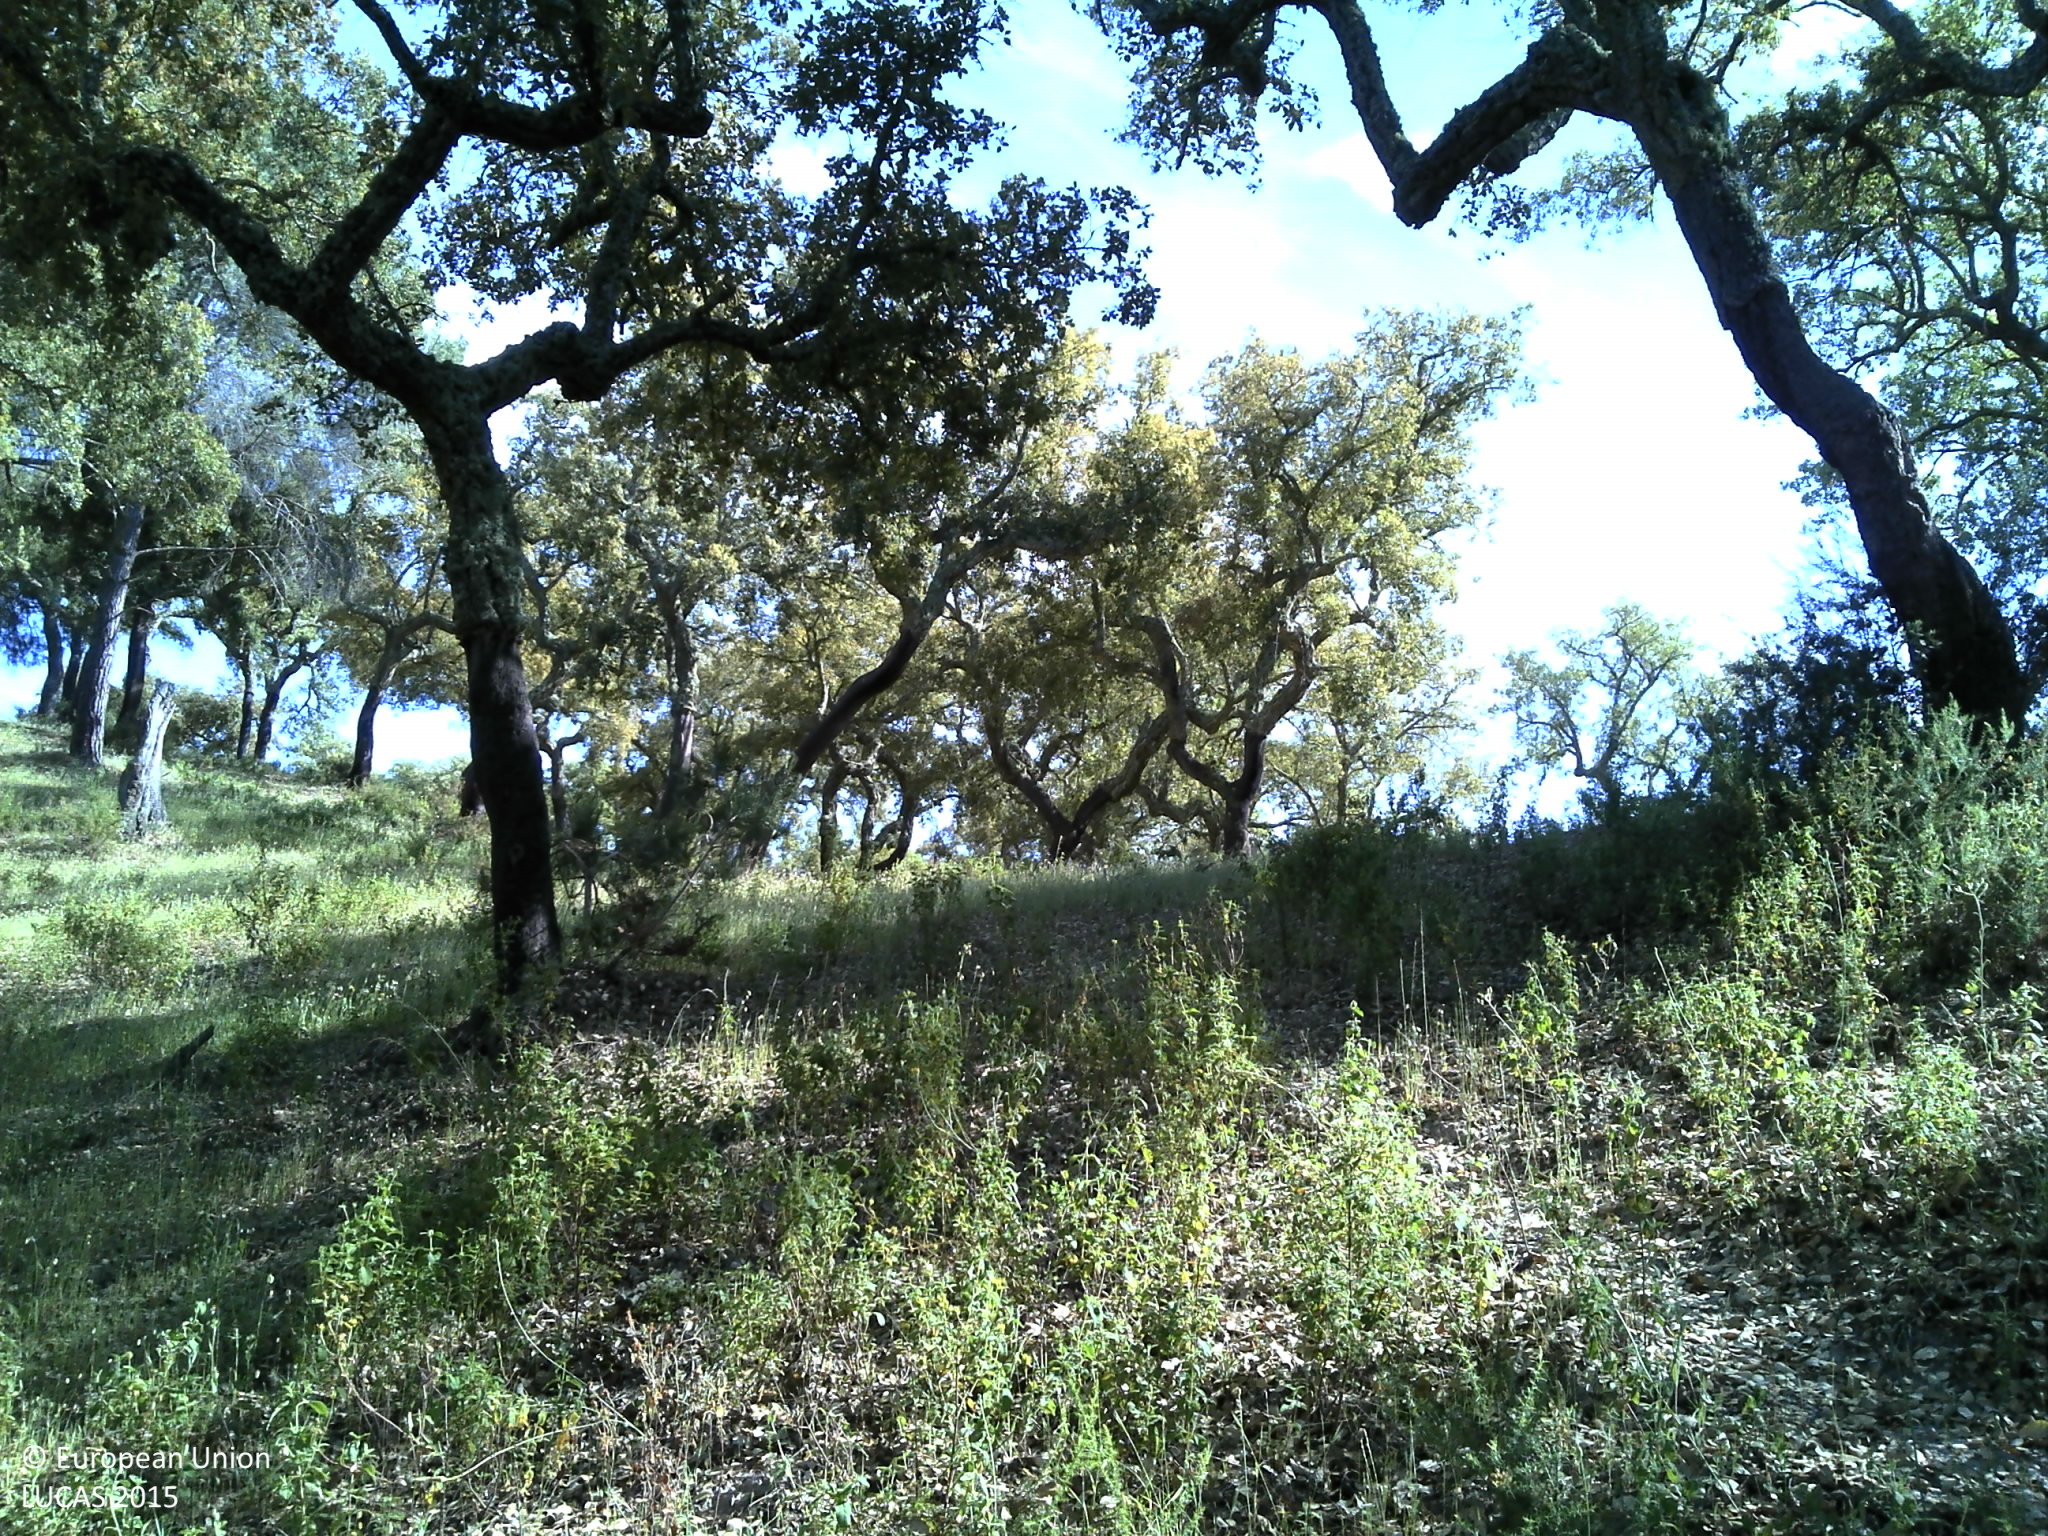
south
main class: Woodland
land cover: Broadleaved woodland
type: broadleaved evergreen forest
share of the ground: 50 - 75 %
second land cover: Grassland without tree/shrub cover
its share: 10 - 25 %
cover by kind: broadleaved forest trees 75 %, herbaceous plants 15 %, unconsolidated bare surface 10 %
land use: Forestry
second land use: Agriculture (excluding fallow land and kitchen gardens)
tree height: > 5 m
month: May
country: PT
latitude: 38.9806
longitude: -8.1656
